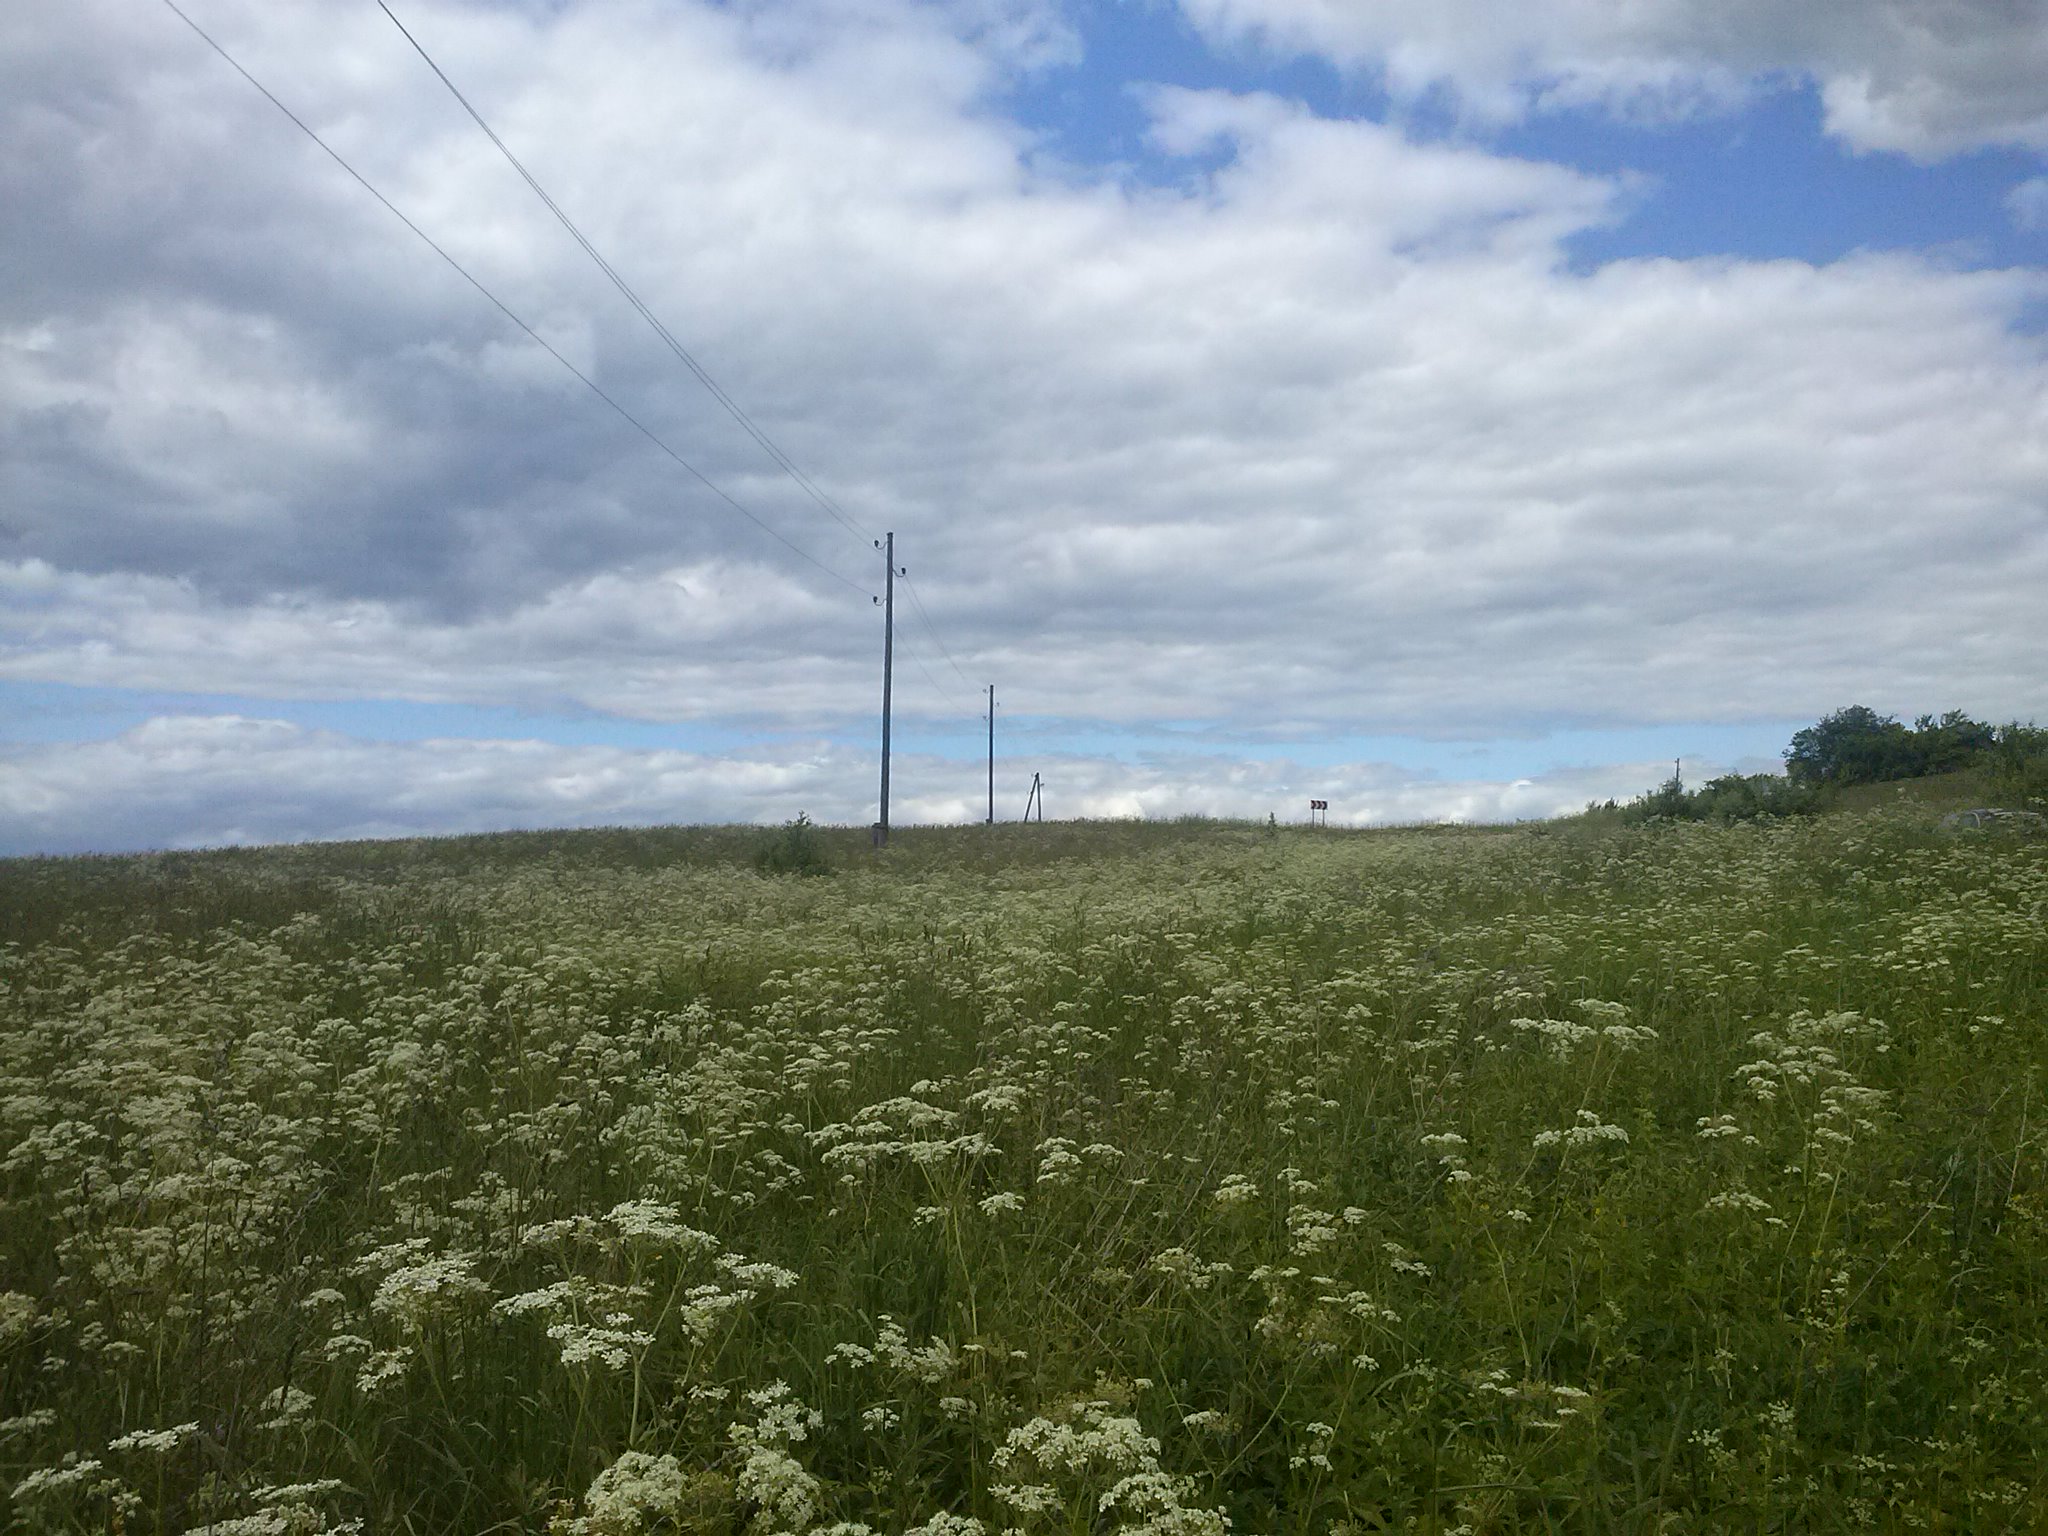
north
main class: Grassland
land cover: Spontaneously vegetated surfaces
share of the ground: > 75 %
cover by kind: herbaceous plants 100 %
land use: Semi-natural and natural areas not in use
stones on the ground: < 10 %
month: June
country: LV
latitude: 56.4224
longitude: 27.6786
